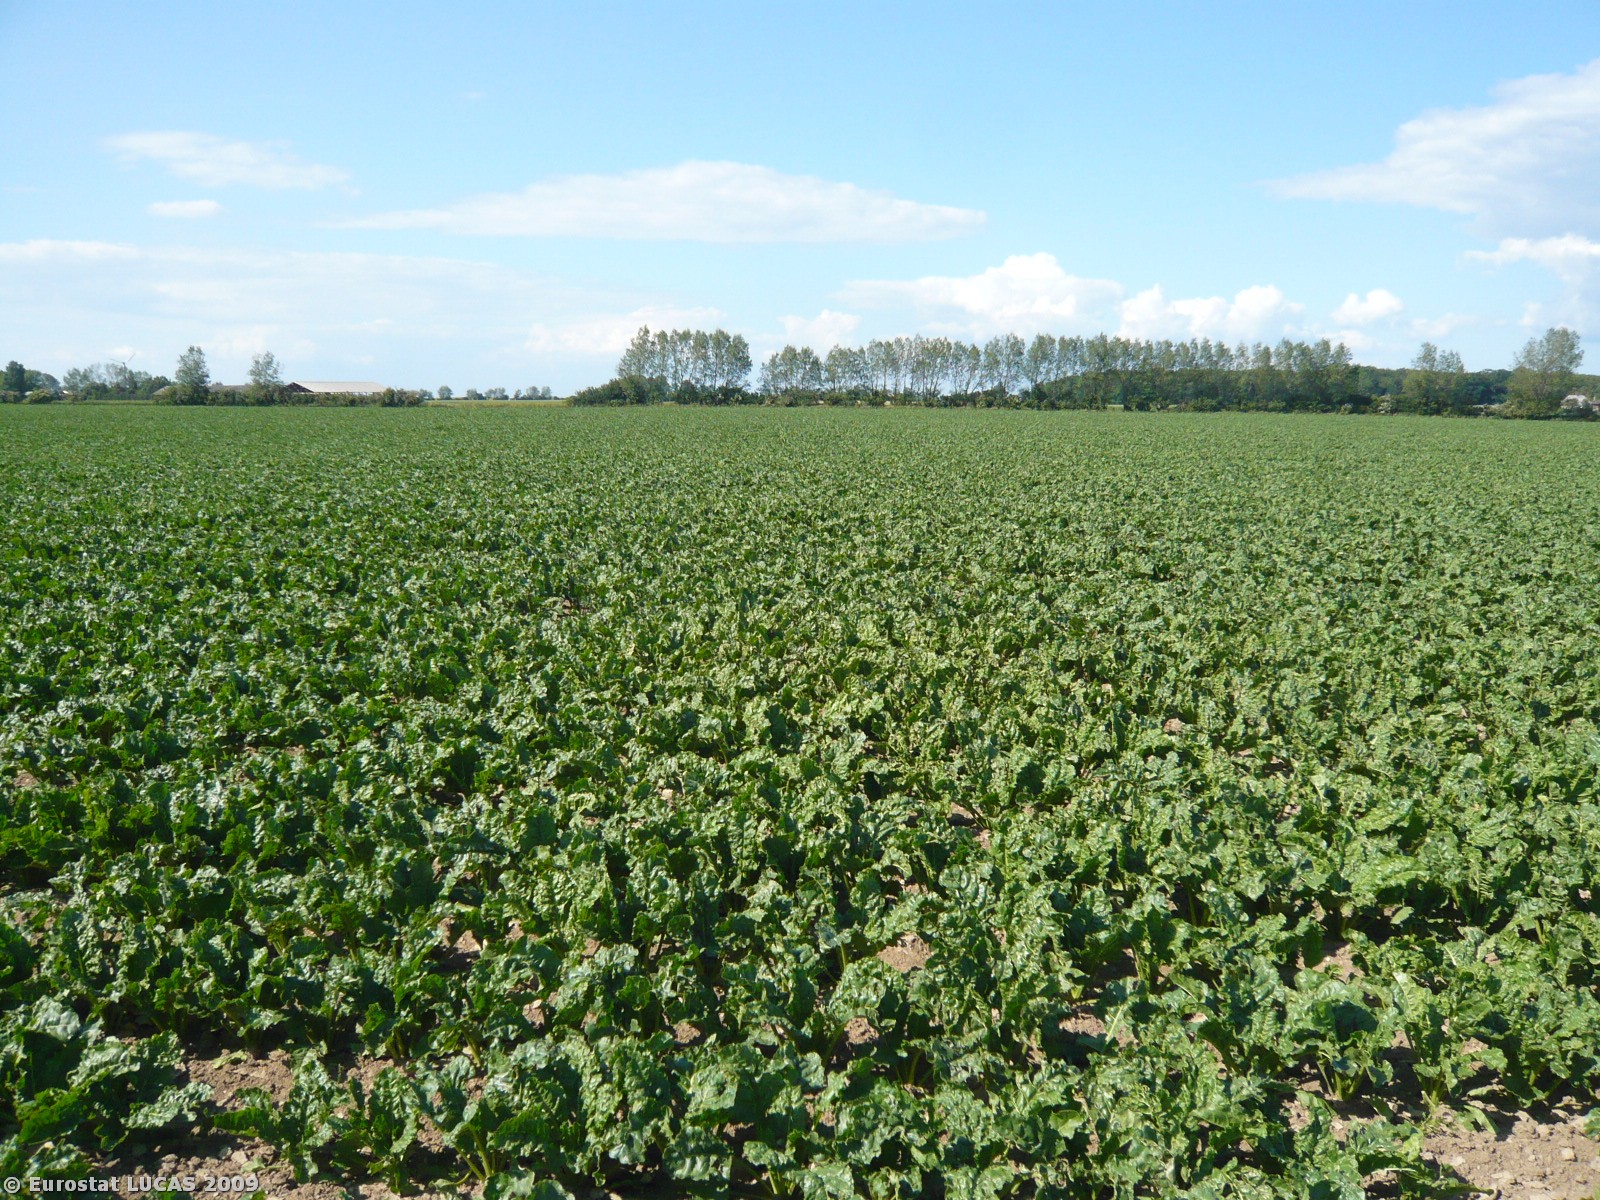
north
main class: Cropland
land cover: Sugar beet
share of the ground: > 75 %
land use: Agriculture (excluding fallow land and kitchen gardens)
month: June
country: DK
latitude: 54.8825
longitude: 11.6667
